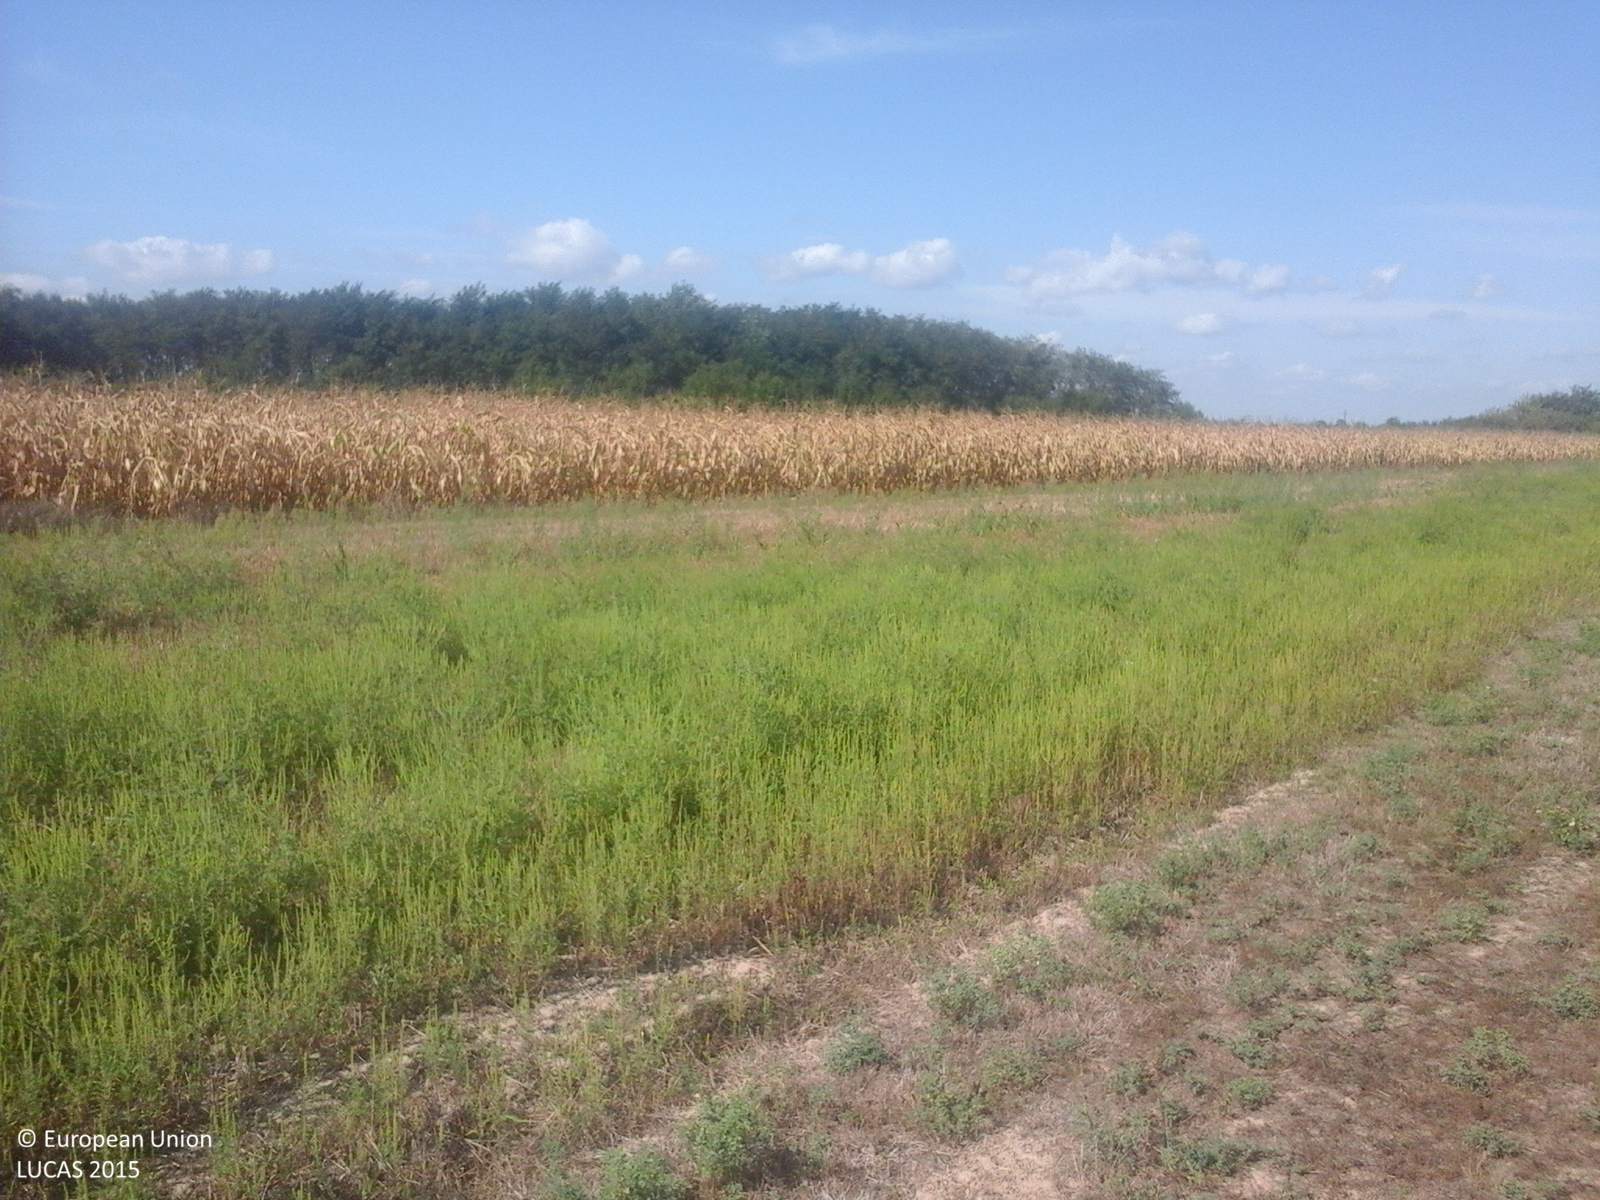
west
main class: Cropland
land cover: Lucerne
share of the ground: > 75 %
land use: Agriculture (excluding fallow land and kitchen gardens)
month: September
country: RO
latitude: 47.9112
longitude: 22.9511
